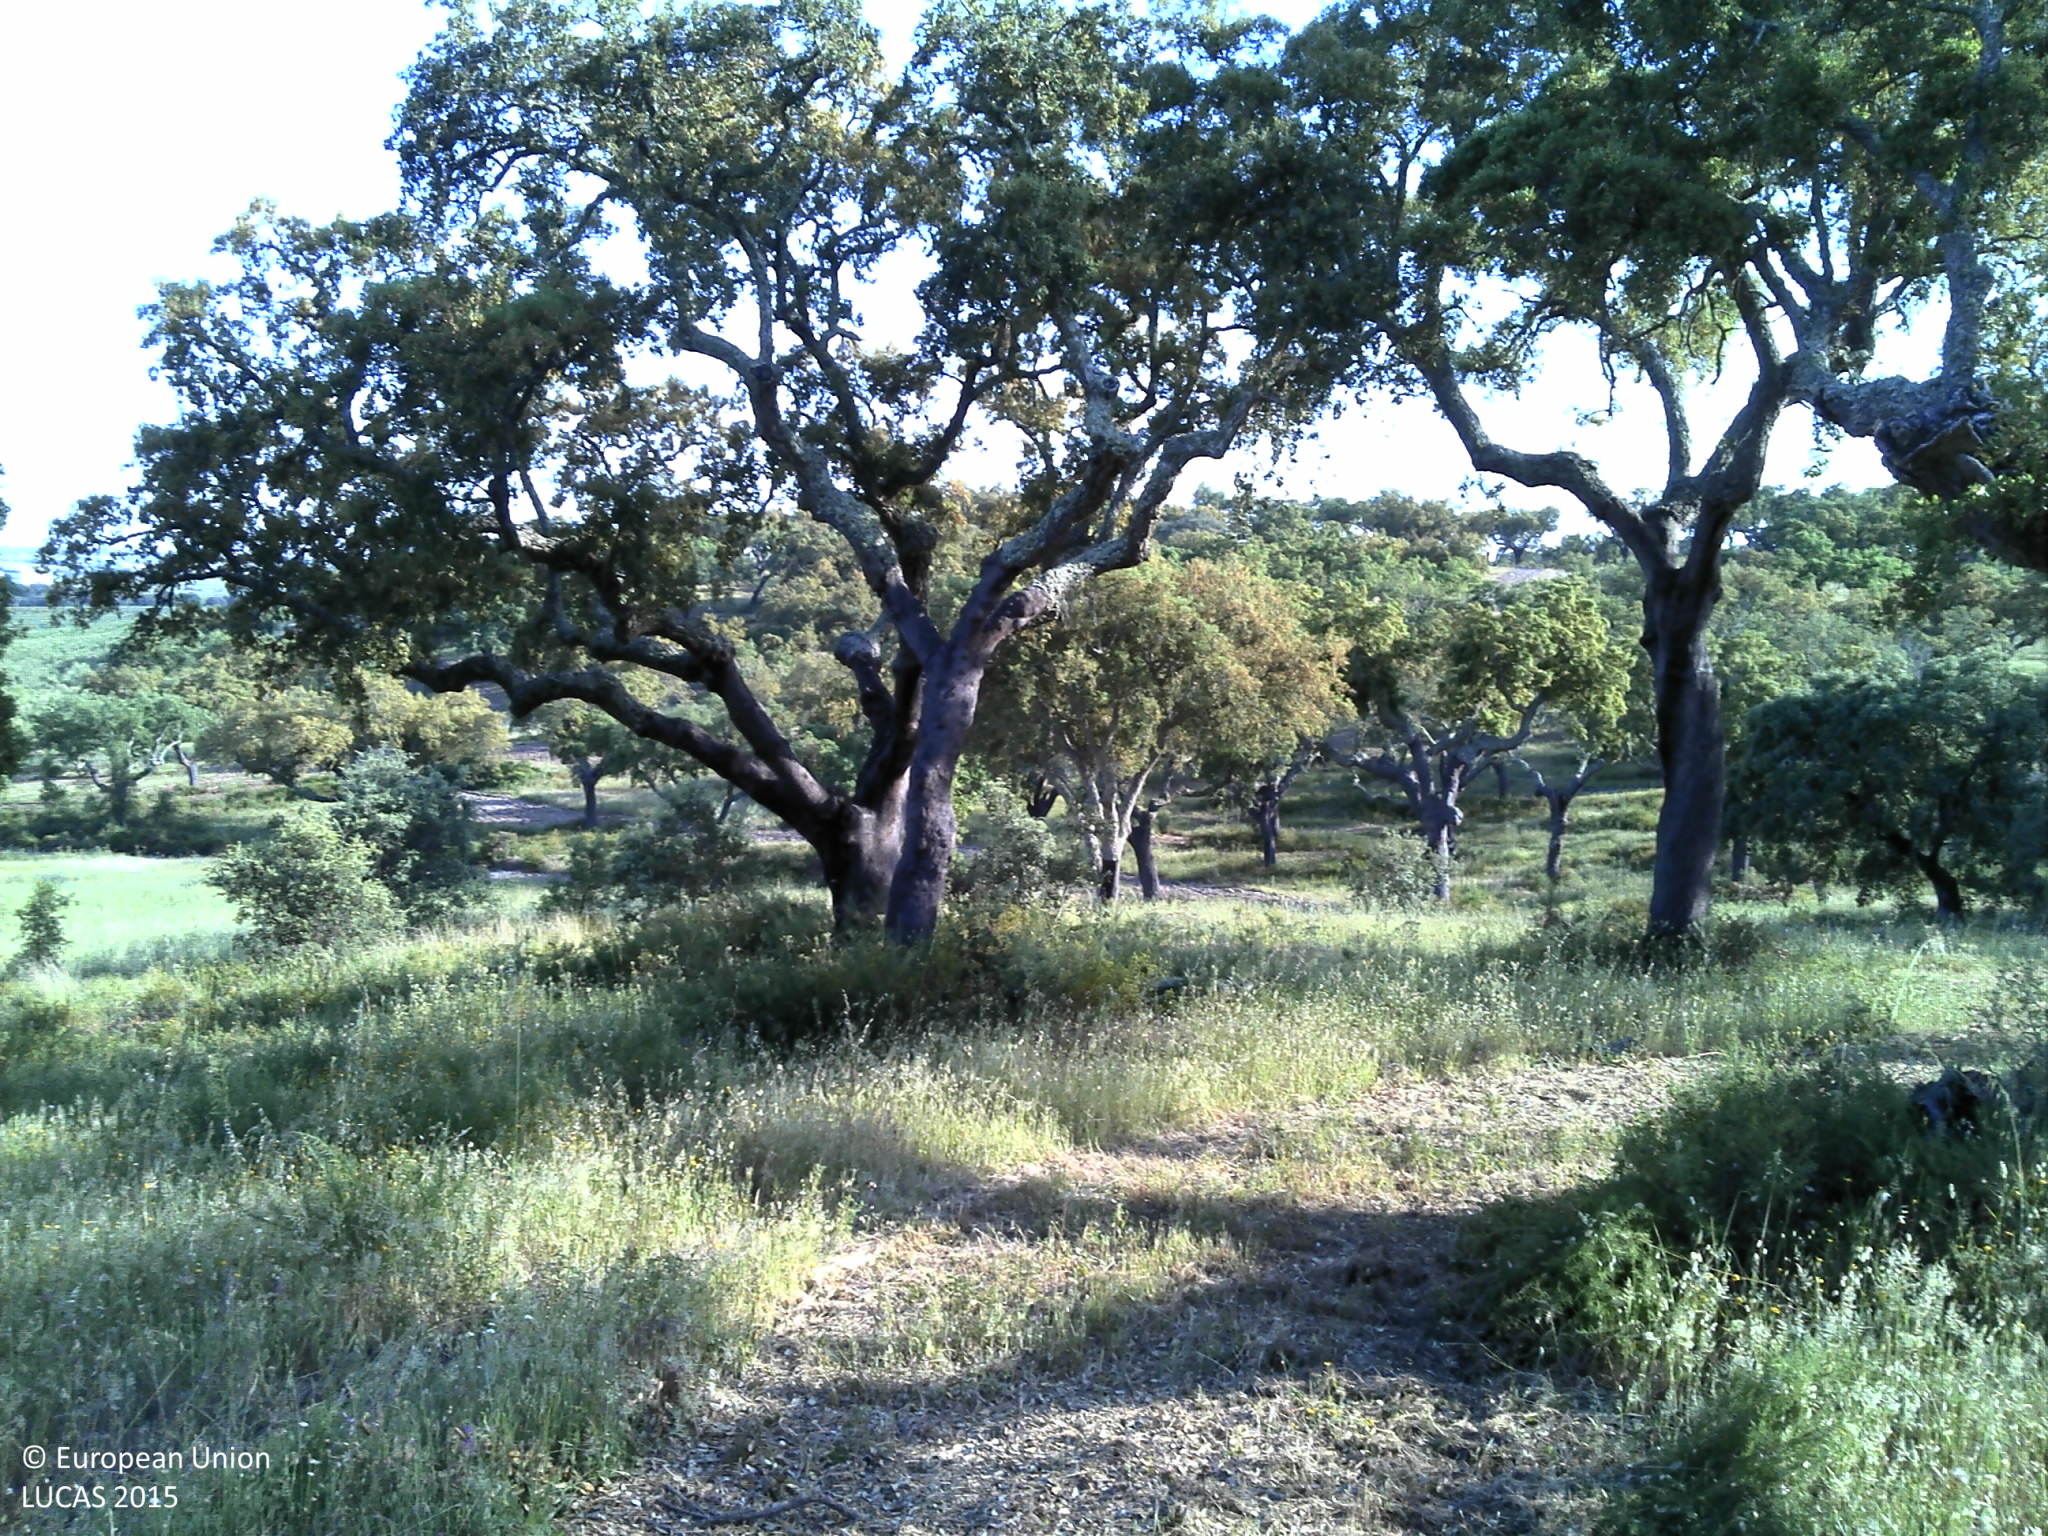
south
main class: Woodland
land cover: Broadleaved woodland
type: broadleaved evergreen forest
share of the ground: 25 - 50 %
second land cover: Grassland without tree/shrub cover
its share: 10 - 25 %
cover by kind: broadleaved forest trees 40 %, herbaceous plants 30 %, consolidated bare surface 30 %
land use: Forestry
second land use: Agriculture (excluding fallow land and kitchen gardens)
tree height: > 5 m
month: May
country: PT
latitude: 39.0845
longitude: -7.9102
